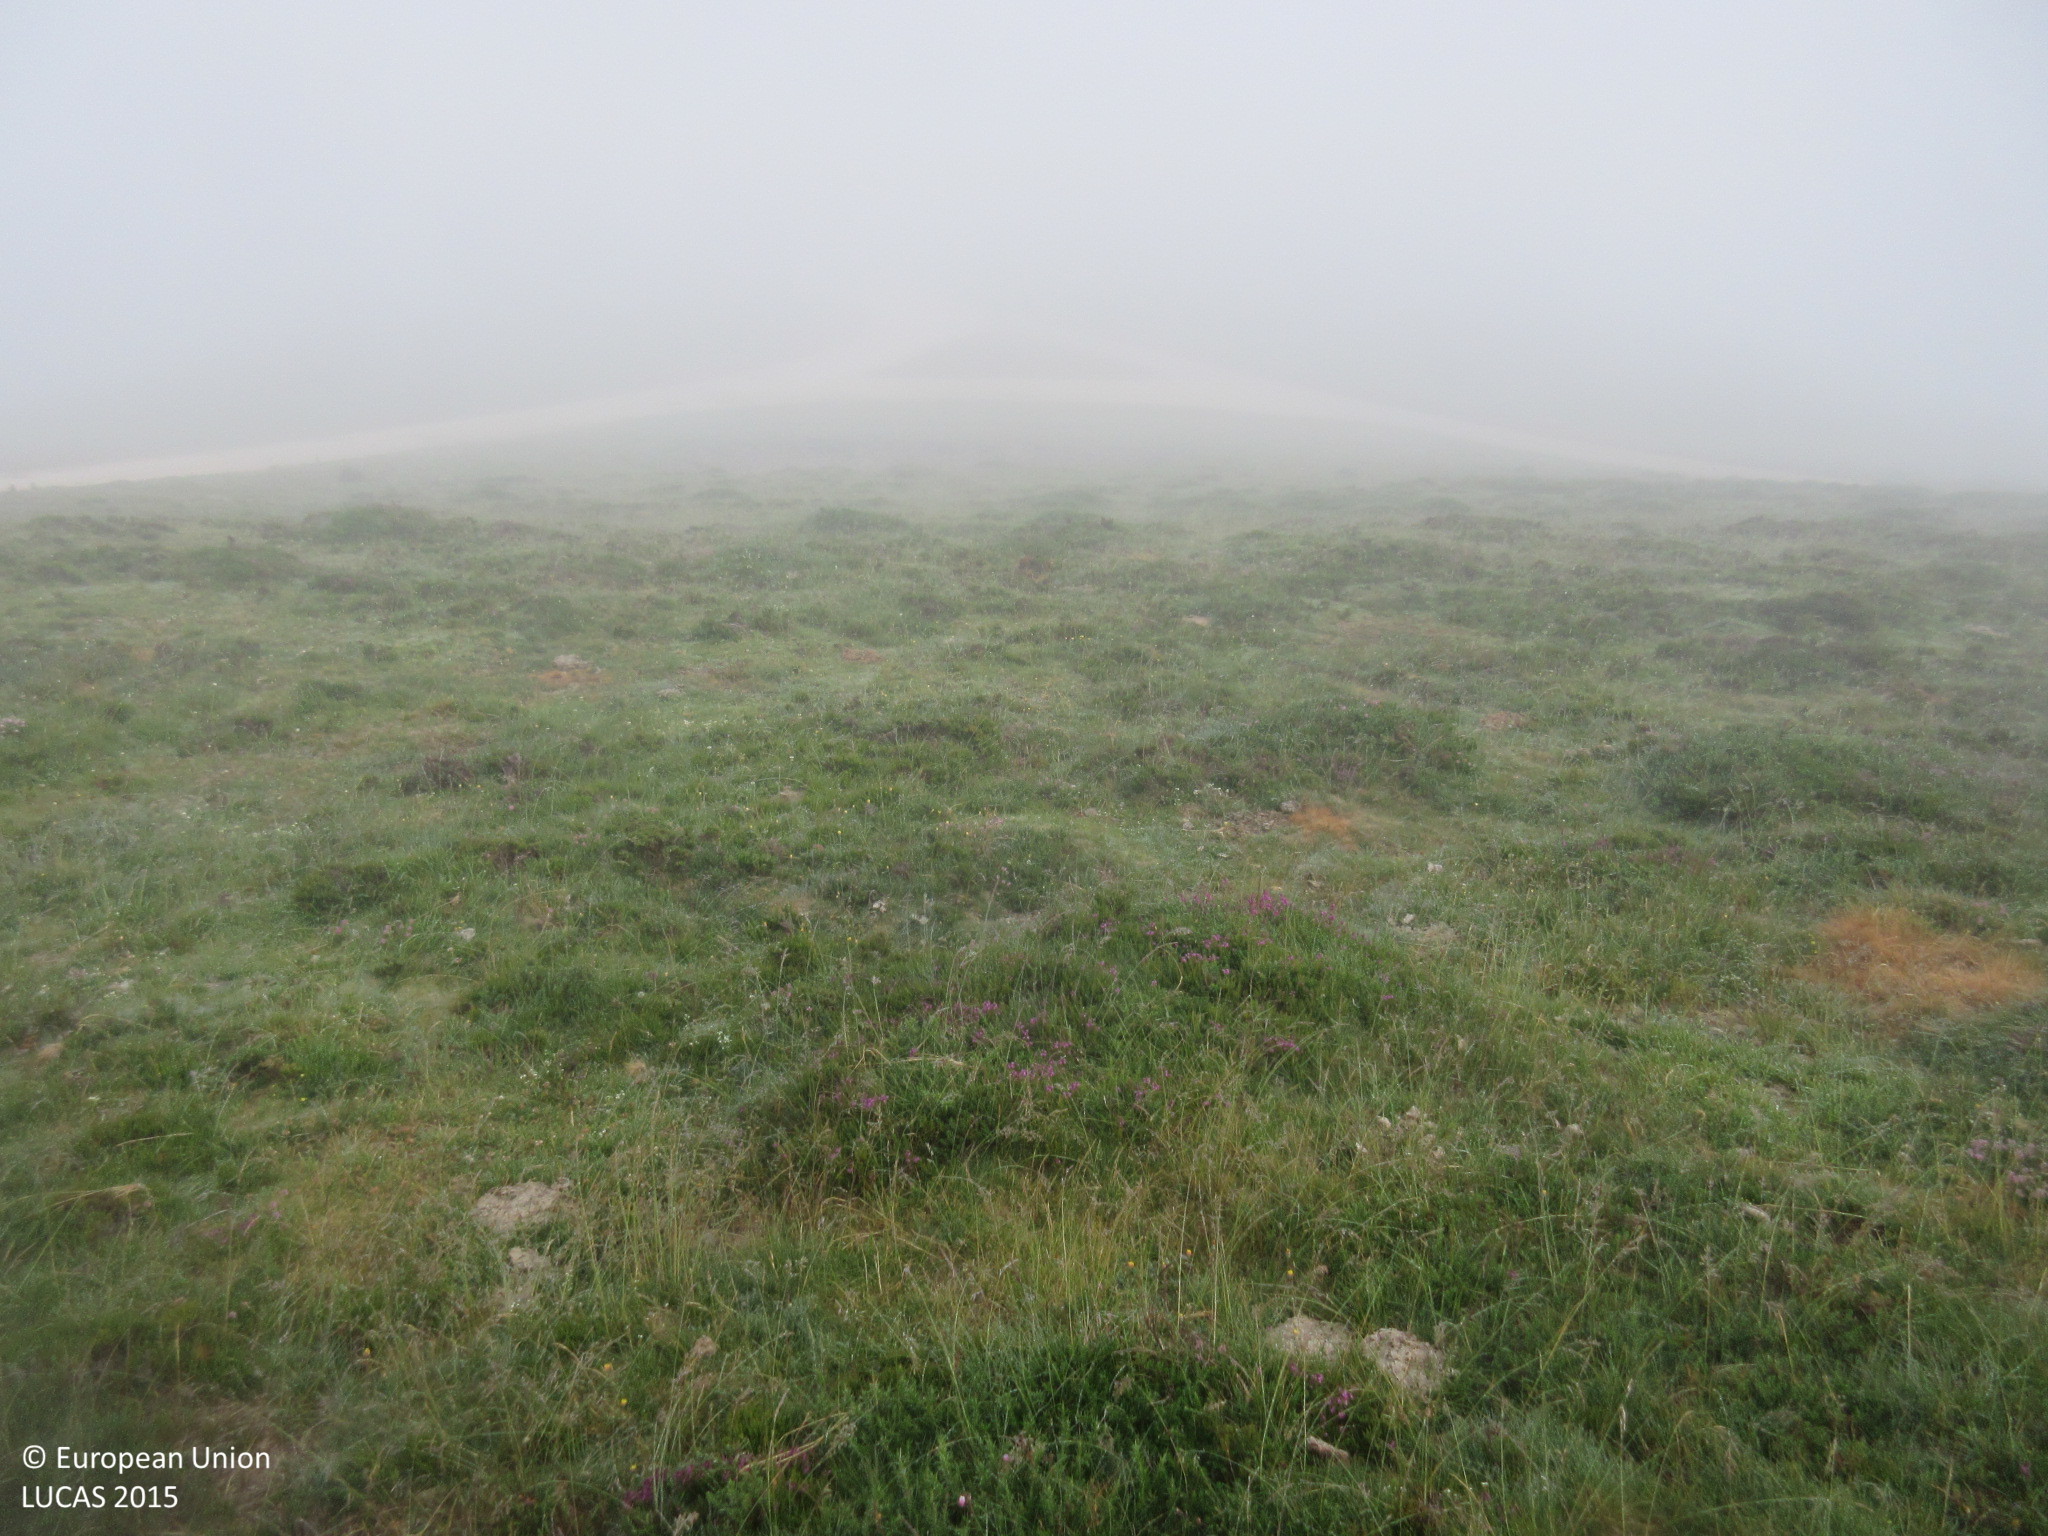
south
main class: Shrubland
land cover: Shrubland without tree cover
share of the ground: 50 - 75 %
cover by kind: shrubs 60 %, herbaceous plants 40 %
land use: Agriculture (excluding fallow land and kitchen gardens)
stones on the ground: 10 - 25 %
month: July
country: ES
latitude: 43.1457
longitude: -3.5553
